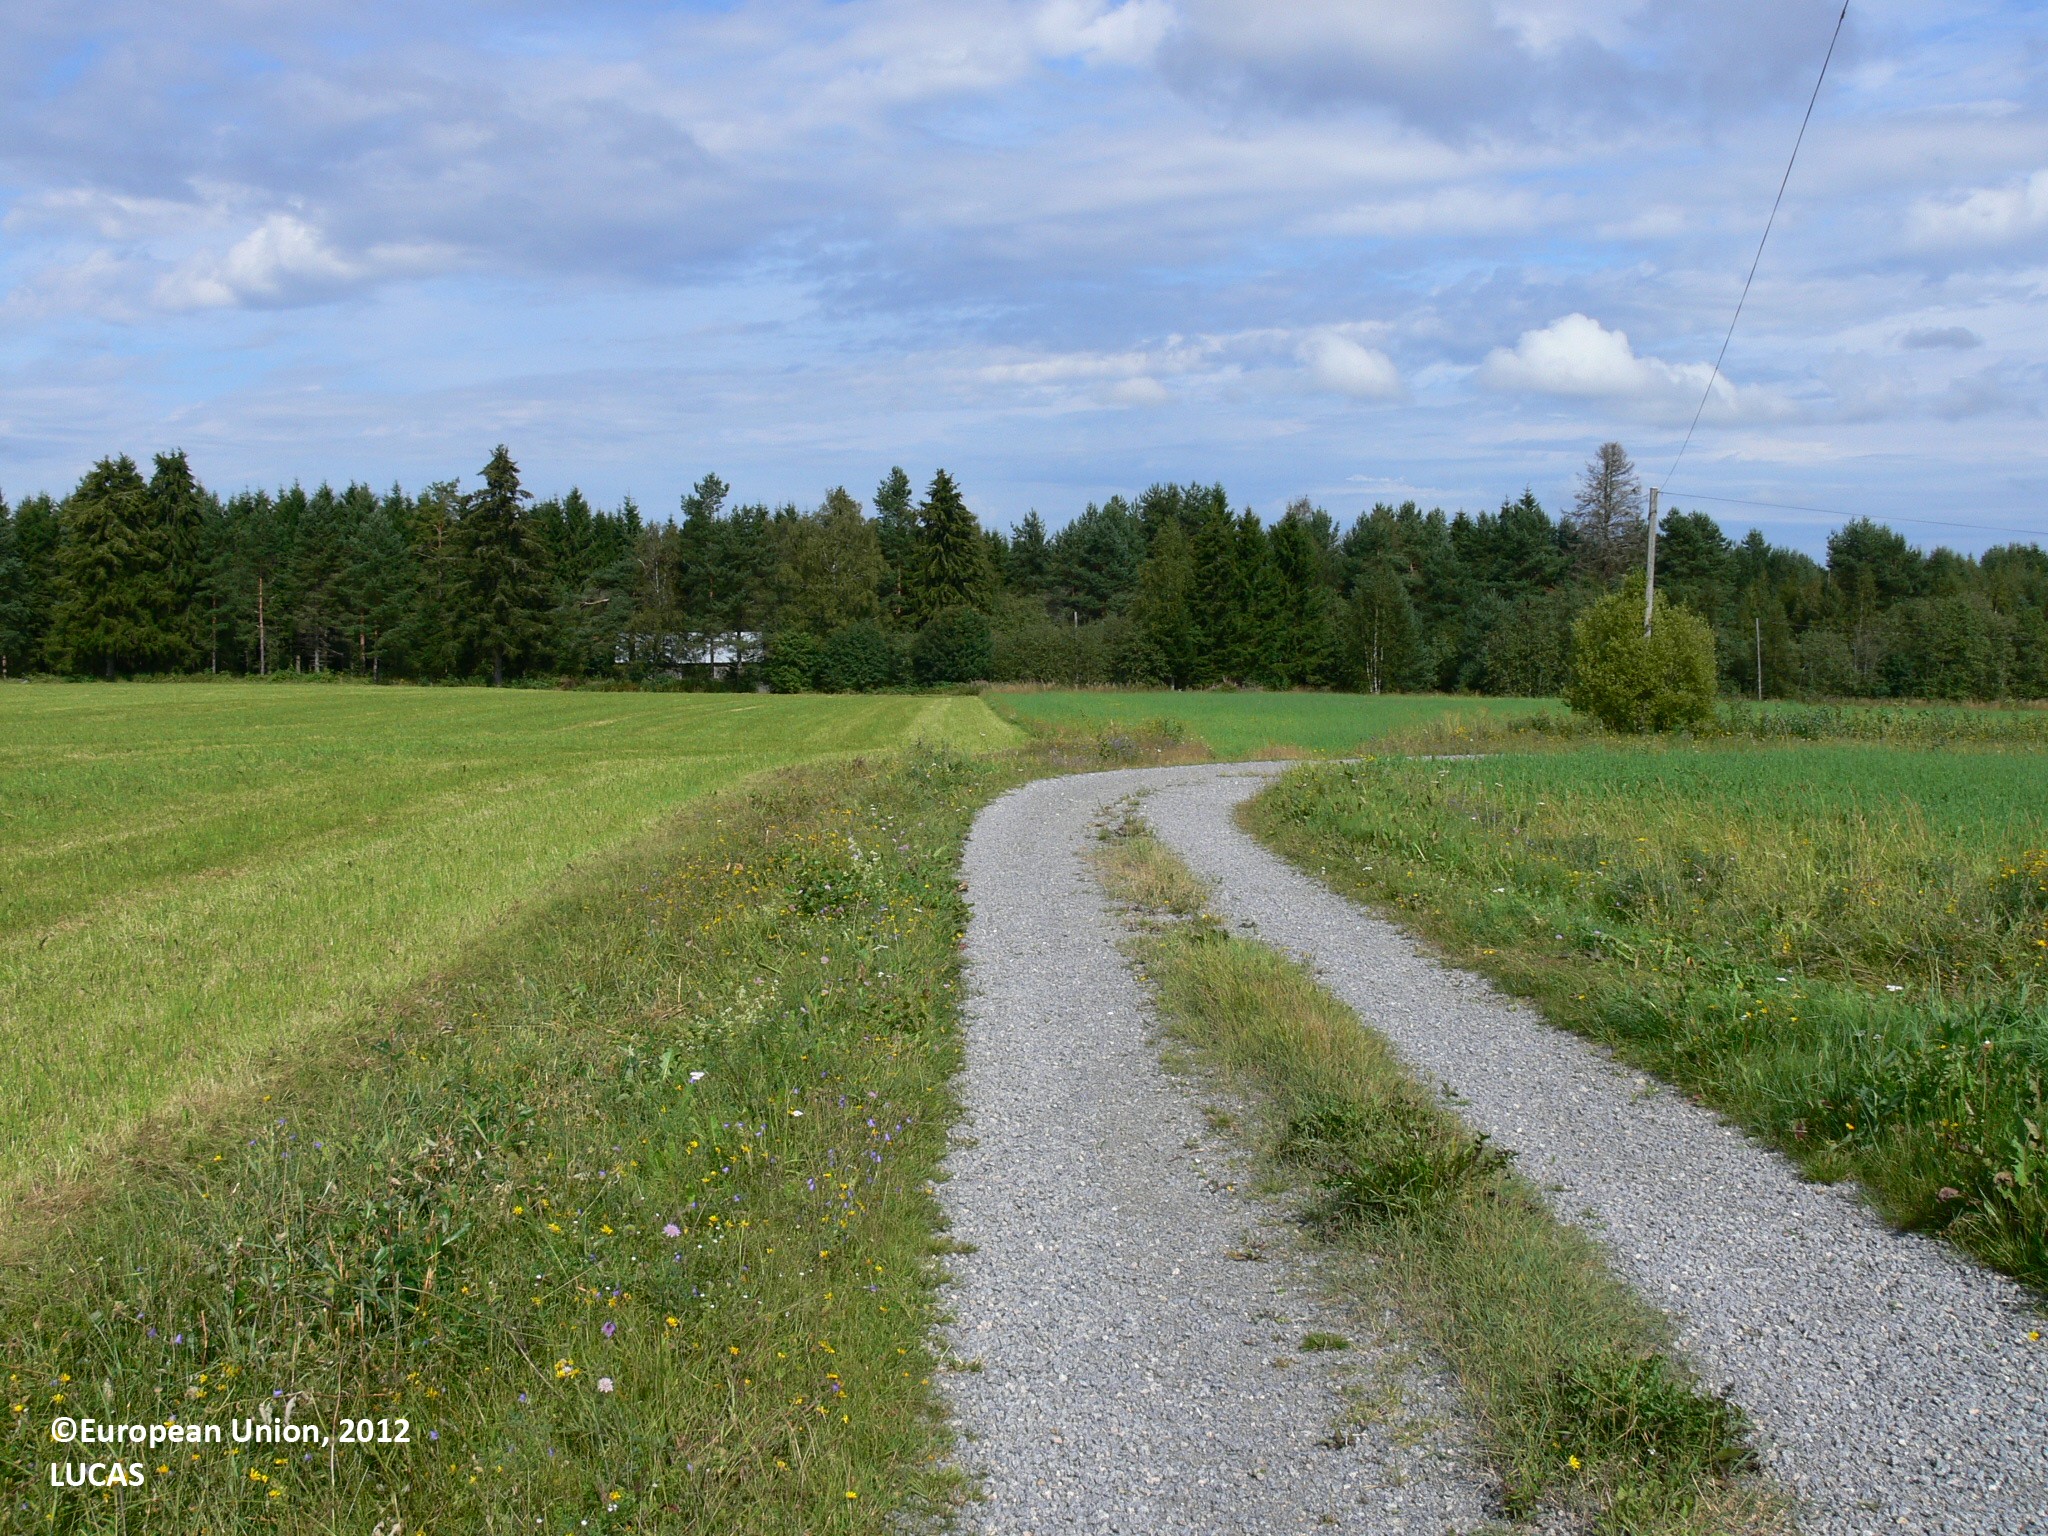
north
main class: Cropland
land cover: Temporary grasslands
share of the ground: 25 - 50 %
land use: Agriculture (excluding fallow land and kitchen gardens)
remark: Harvested field
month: August
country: FI
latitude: 61.6655
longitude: 29.8099
